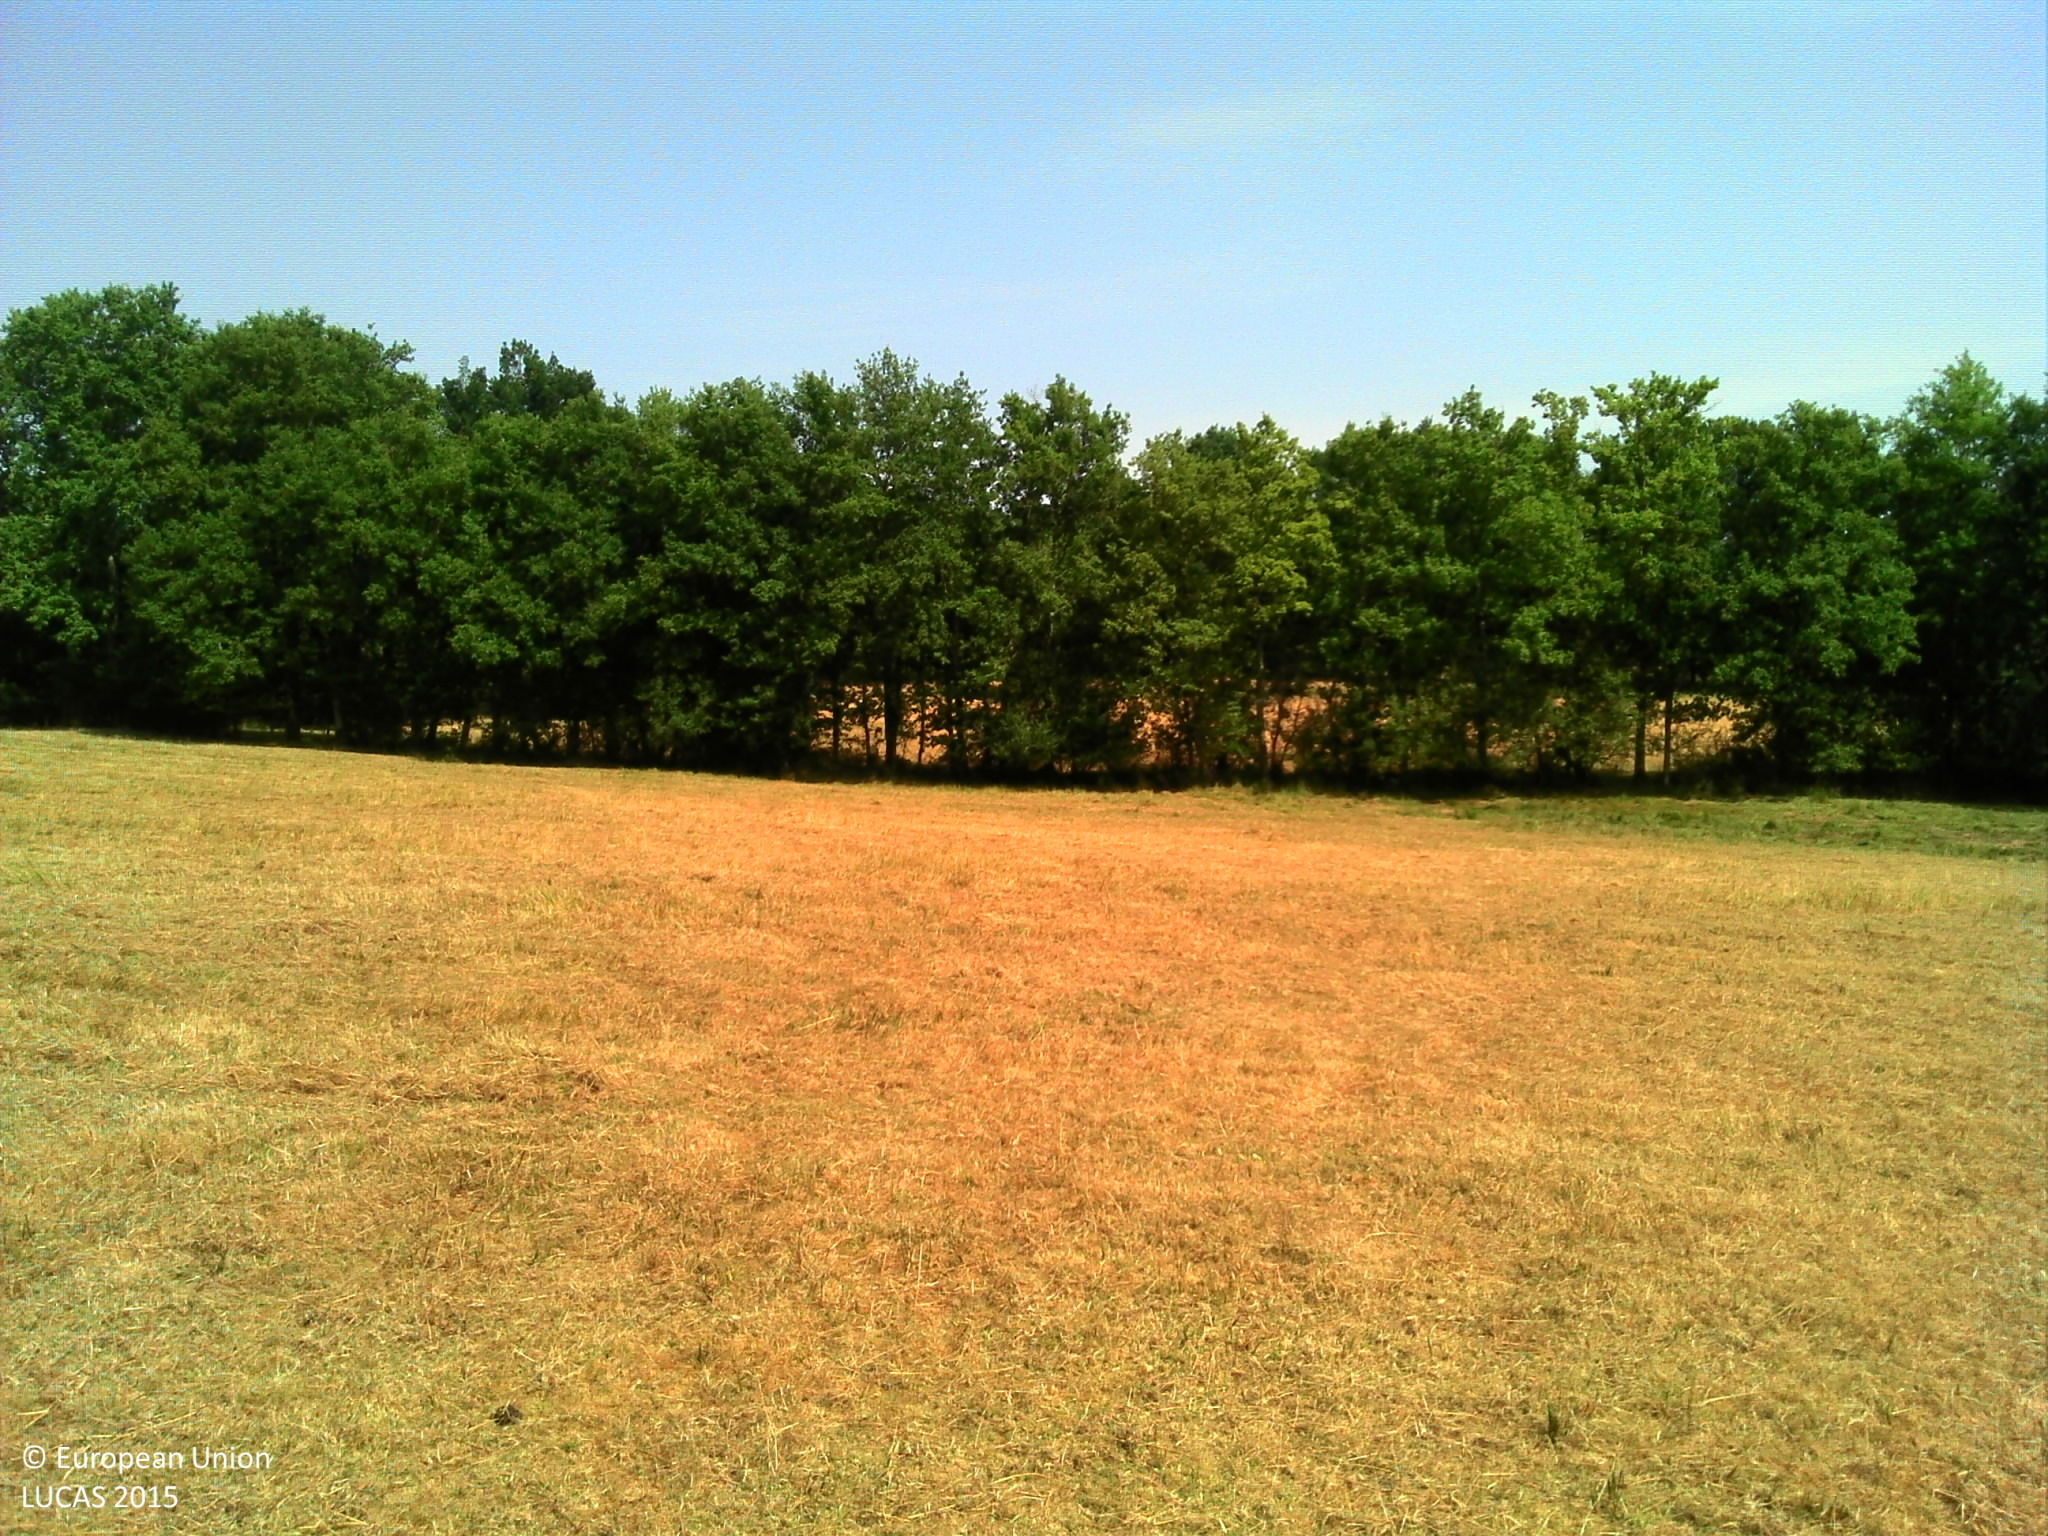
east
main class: Grassland
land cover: Grassland without tree/shrub cover
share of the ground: > 75 %
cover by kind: herbaceous plants 95 %
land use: Agriculture (excluding fallow land and kitchen gardens)
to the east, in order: Grassland without tree/shrub cover; Lines of trees; Fences; Grassland without tree/shrub cover; Fences; Lines of trees; Spontaneously vegetated surfaces; Electric lines; Grass margins; Paved roads, cycling and walking lanes; Grass margins; Fences; Abandoned hedges; Other leguminous and mixtures for fodder; Electric lines; Grass margins; Paved roads, cycling and walking lanes; Grass margins; Fences; Grass margins; Paved roads, cycling and walking lanes; Managed hedges
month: July
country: FR
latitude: 45.7719
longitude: 1.0004
